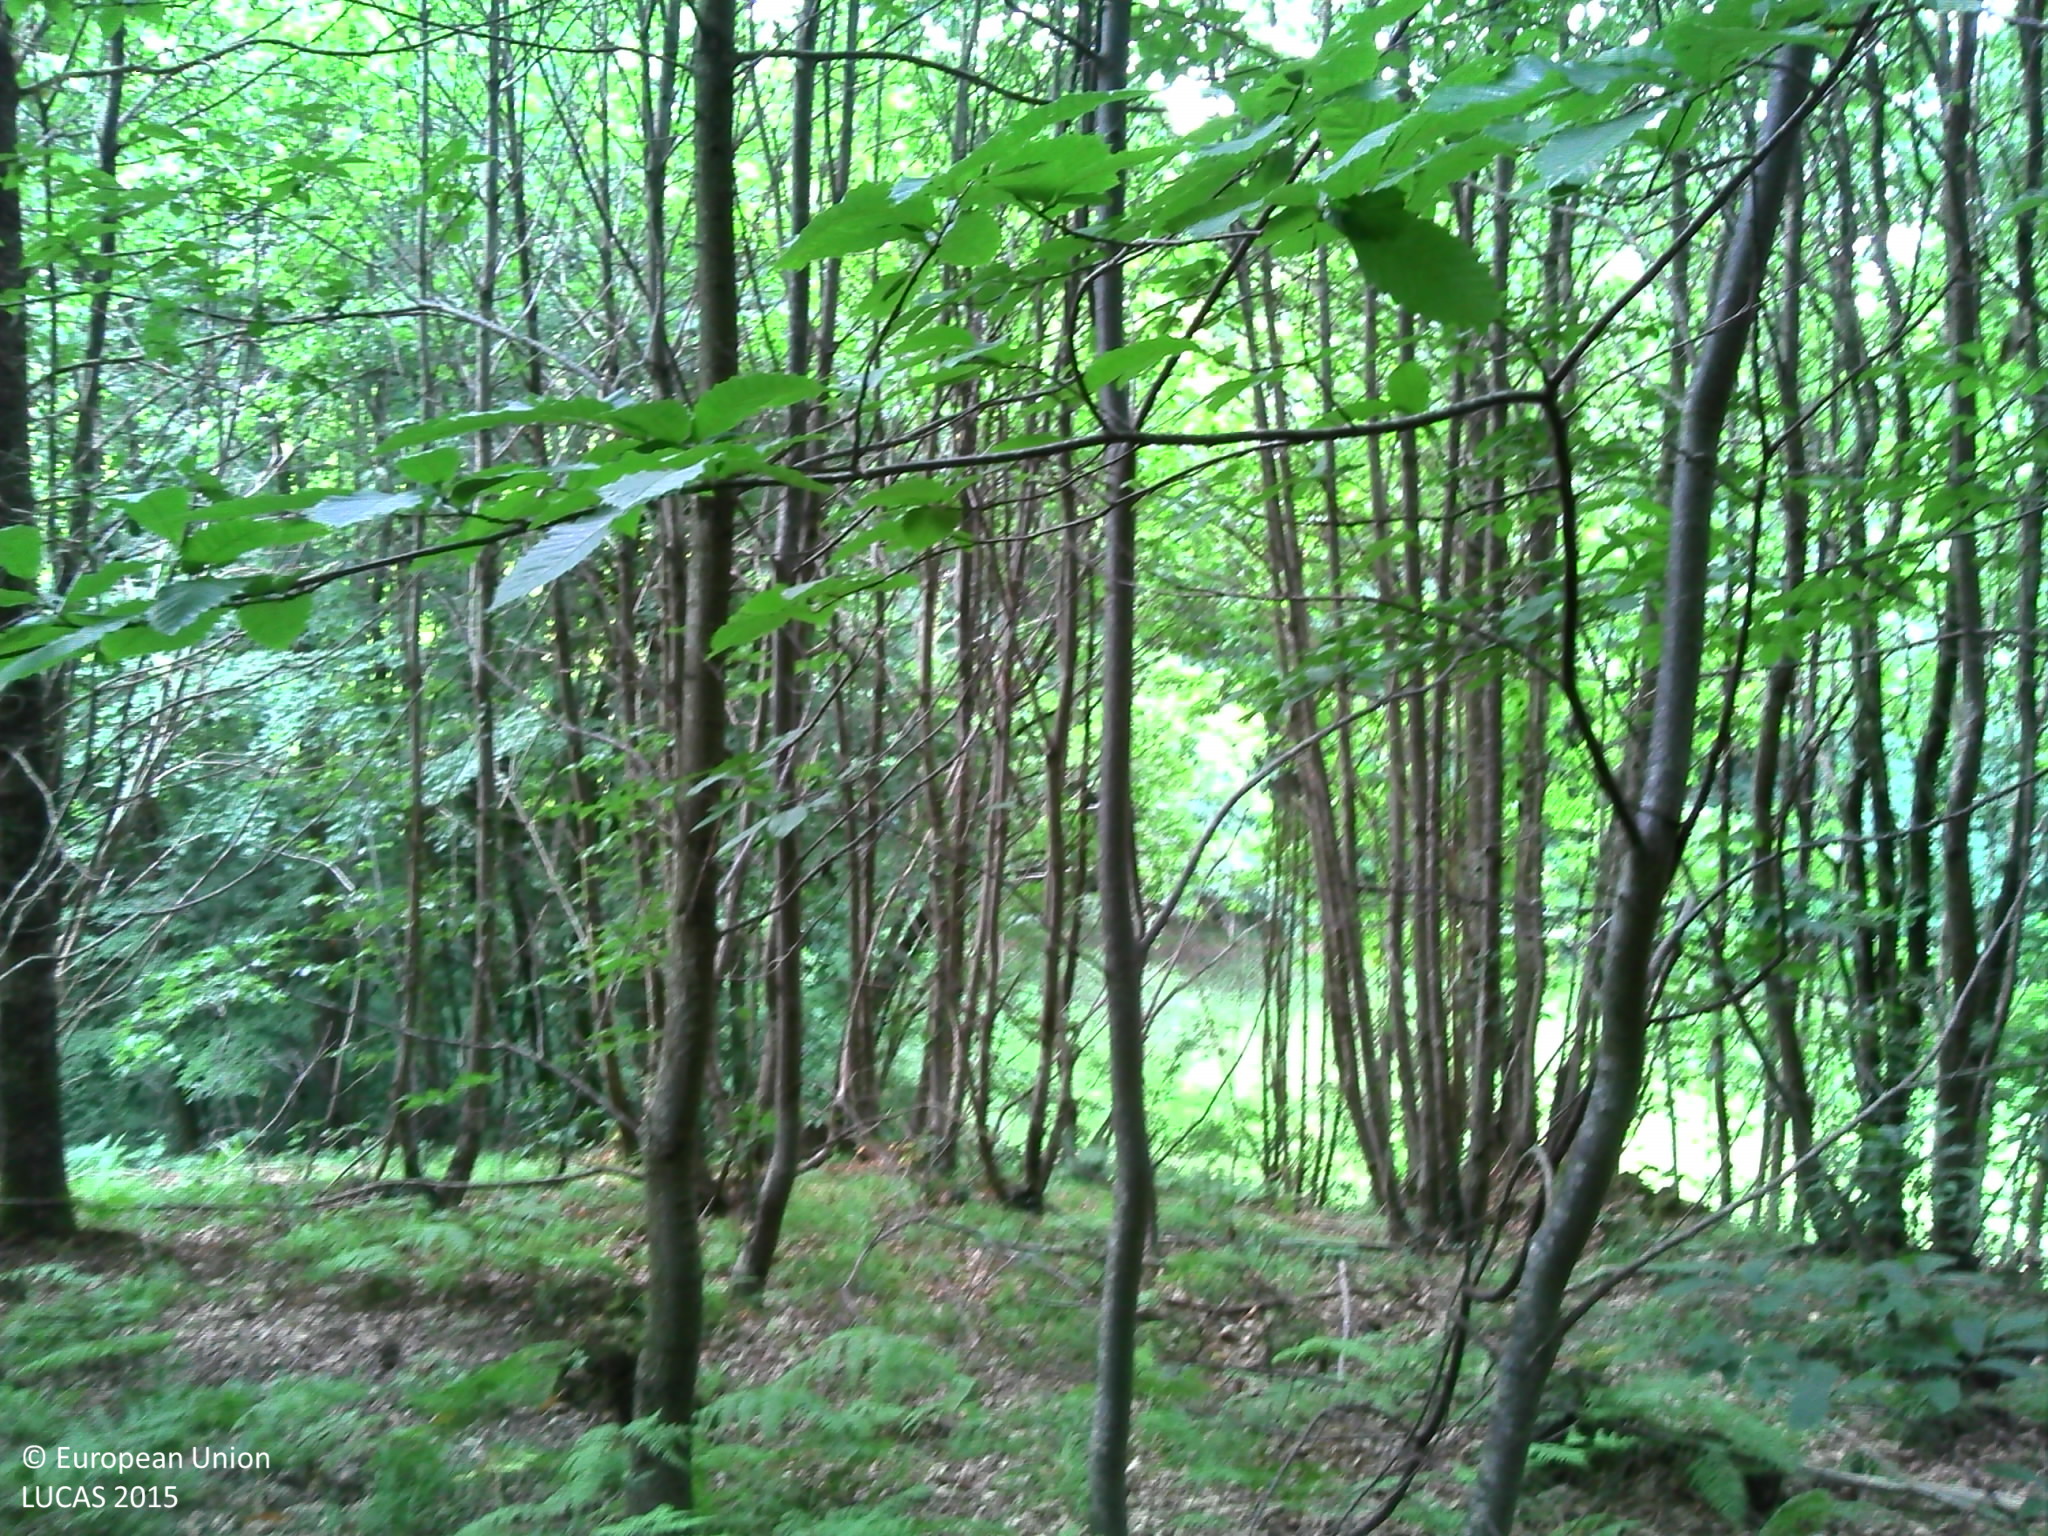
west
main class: Woodland
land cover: Broadleaved woodland
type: mesophytic deciduous forest
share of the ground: > 75 %
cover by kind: broadleaved forest trees 100 %
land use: Forestry
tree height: > 5 m
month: August
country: FR
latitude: 48.7016
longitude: -1.2268
